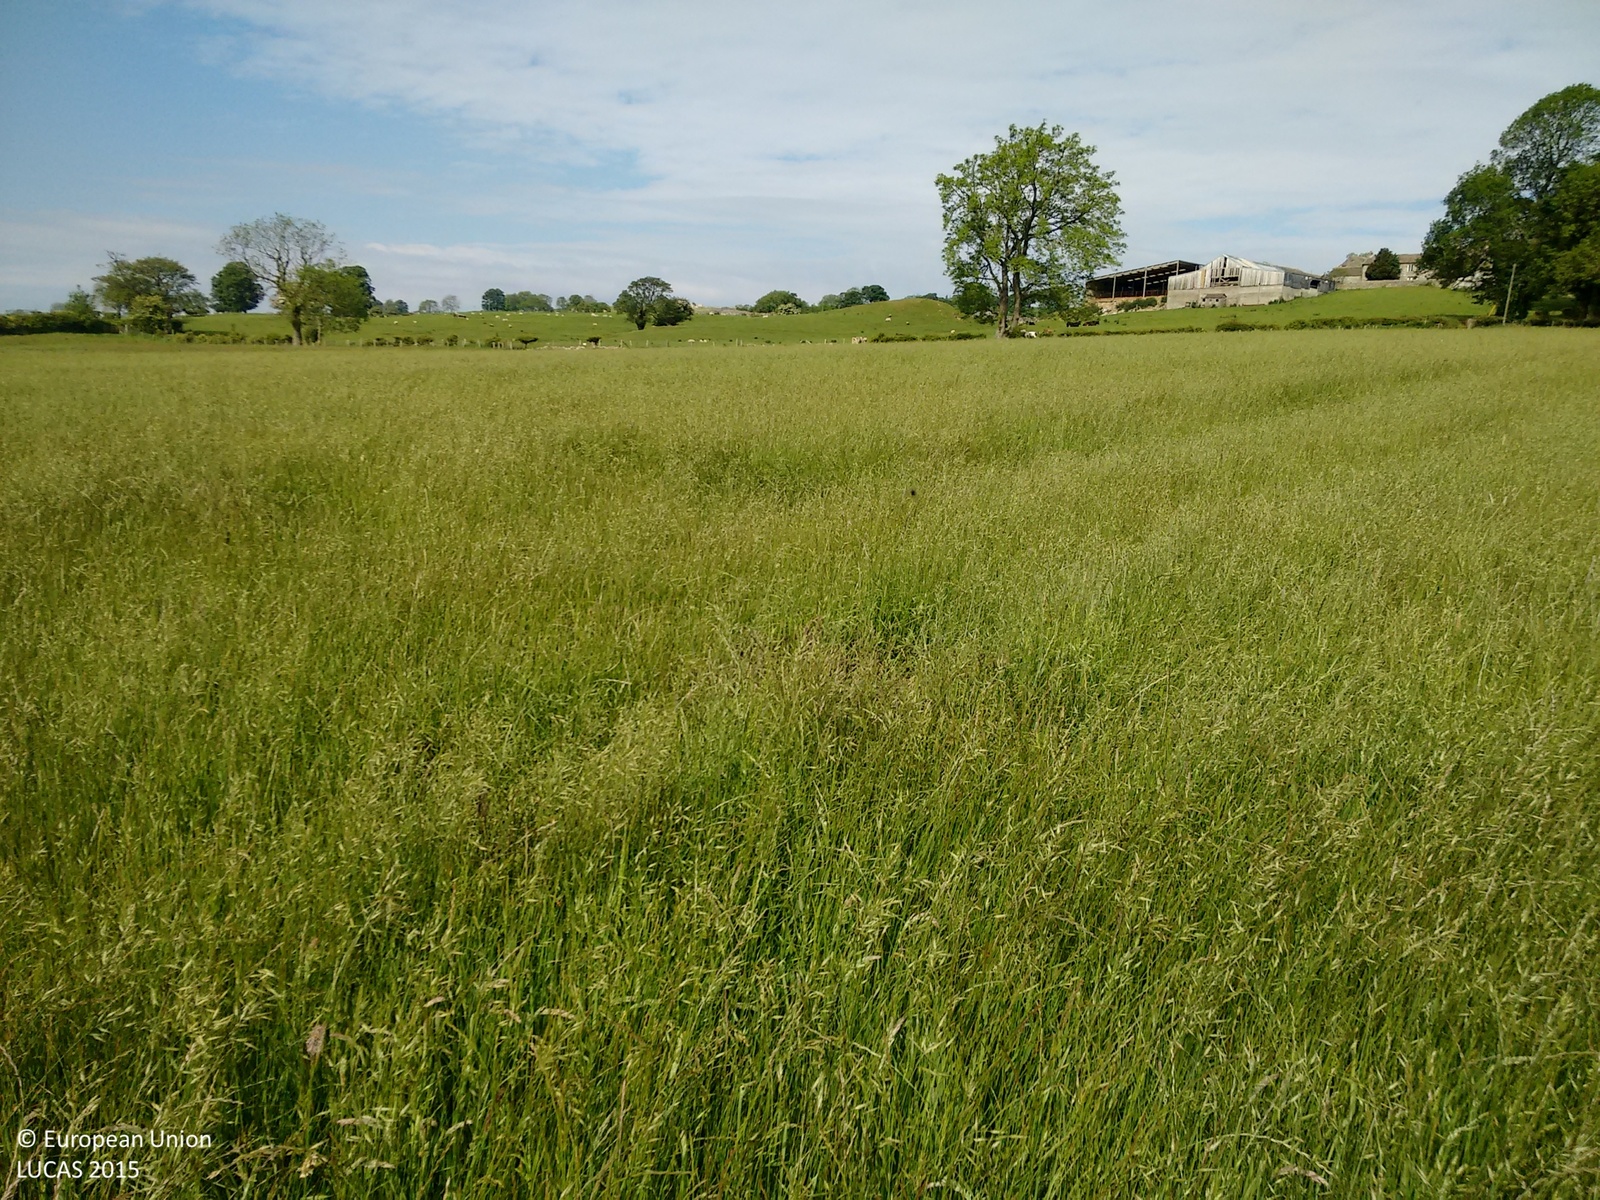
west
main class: Grassland
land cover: Grassland without tree/shrub cover
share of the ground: > 75 %
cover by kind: herbaceous plants 100 %
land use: Agriculture (excluding fallow land and kitchen gardens)
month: June
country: GB
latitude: 54.2710
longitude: -1.8626
